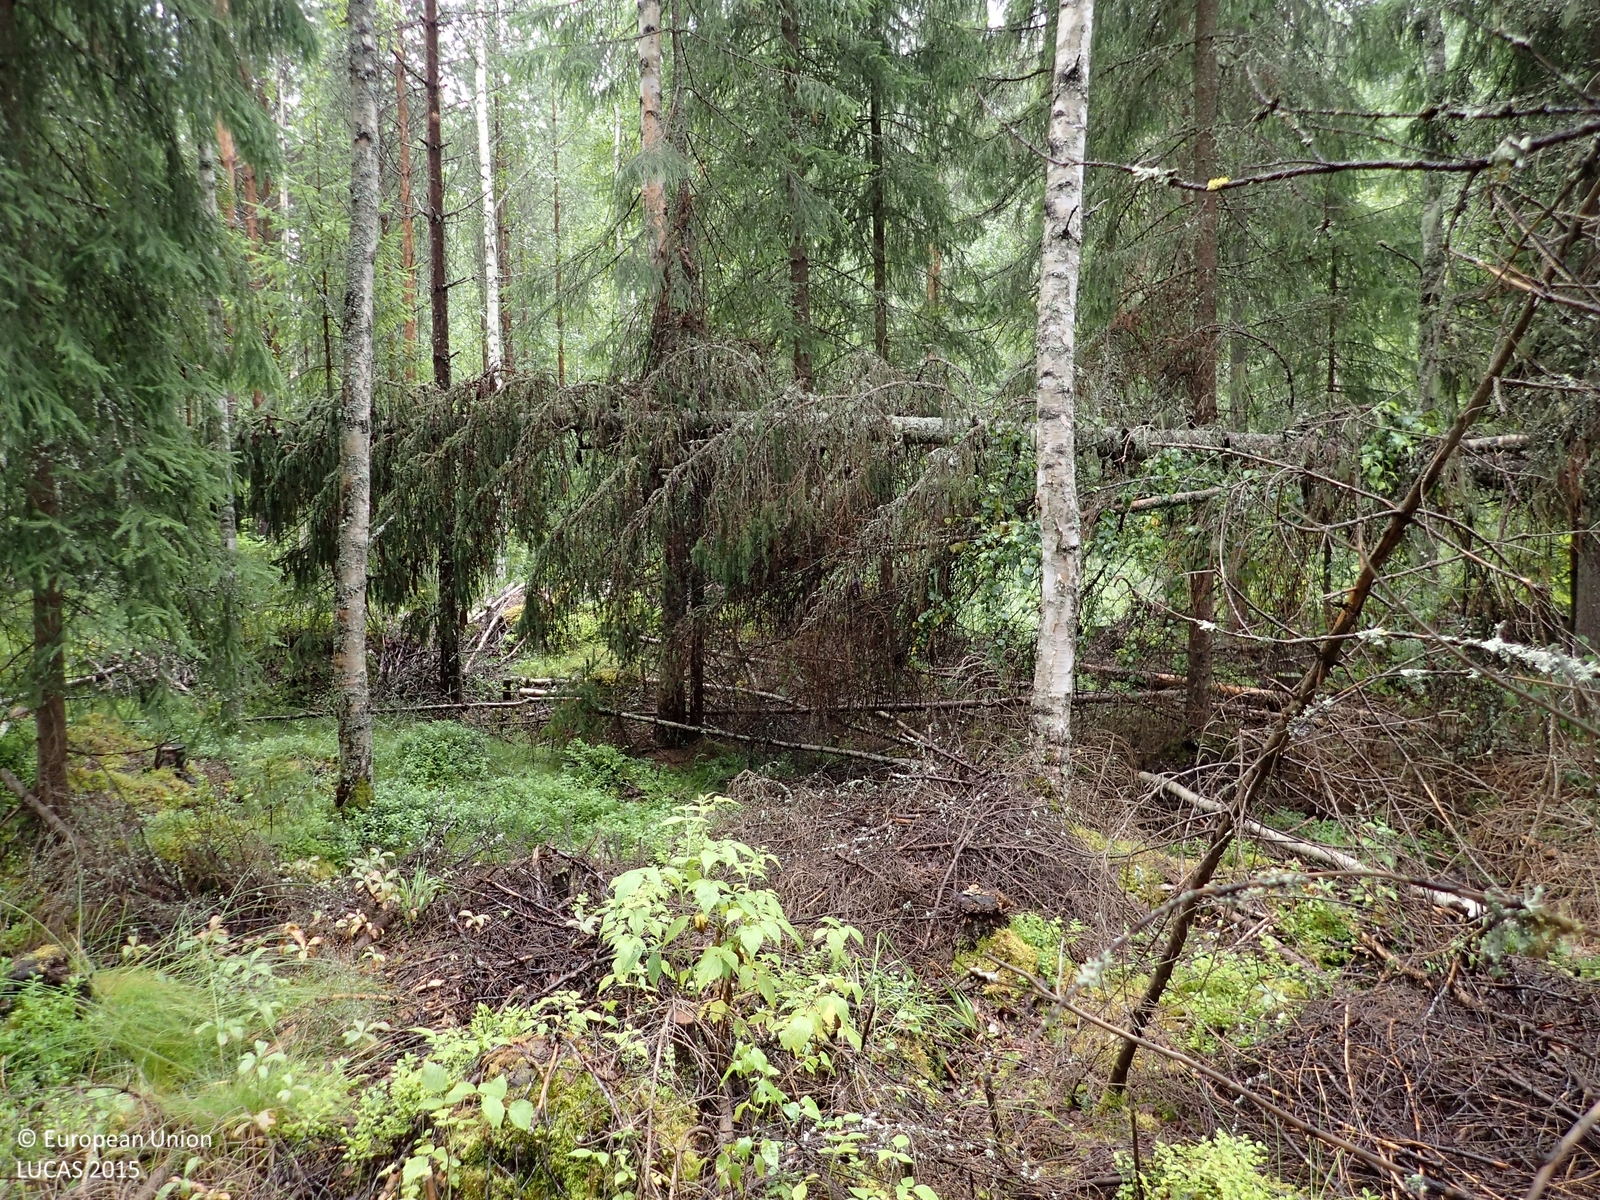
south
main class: Woodland
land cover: Spruce dominated mixed woodland
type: boreal forest
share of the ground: > 75 %
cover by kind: coniferous forest trees 55 %, broadleaved forest trees 20 %, shrubs 15 %, herbaceous plants 5 %, lichens and mosses 5 %
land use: Forestry
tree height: > 5 m
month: July
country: FI
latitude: 62.9774
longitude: 22.8205
